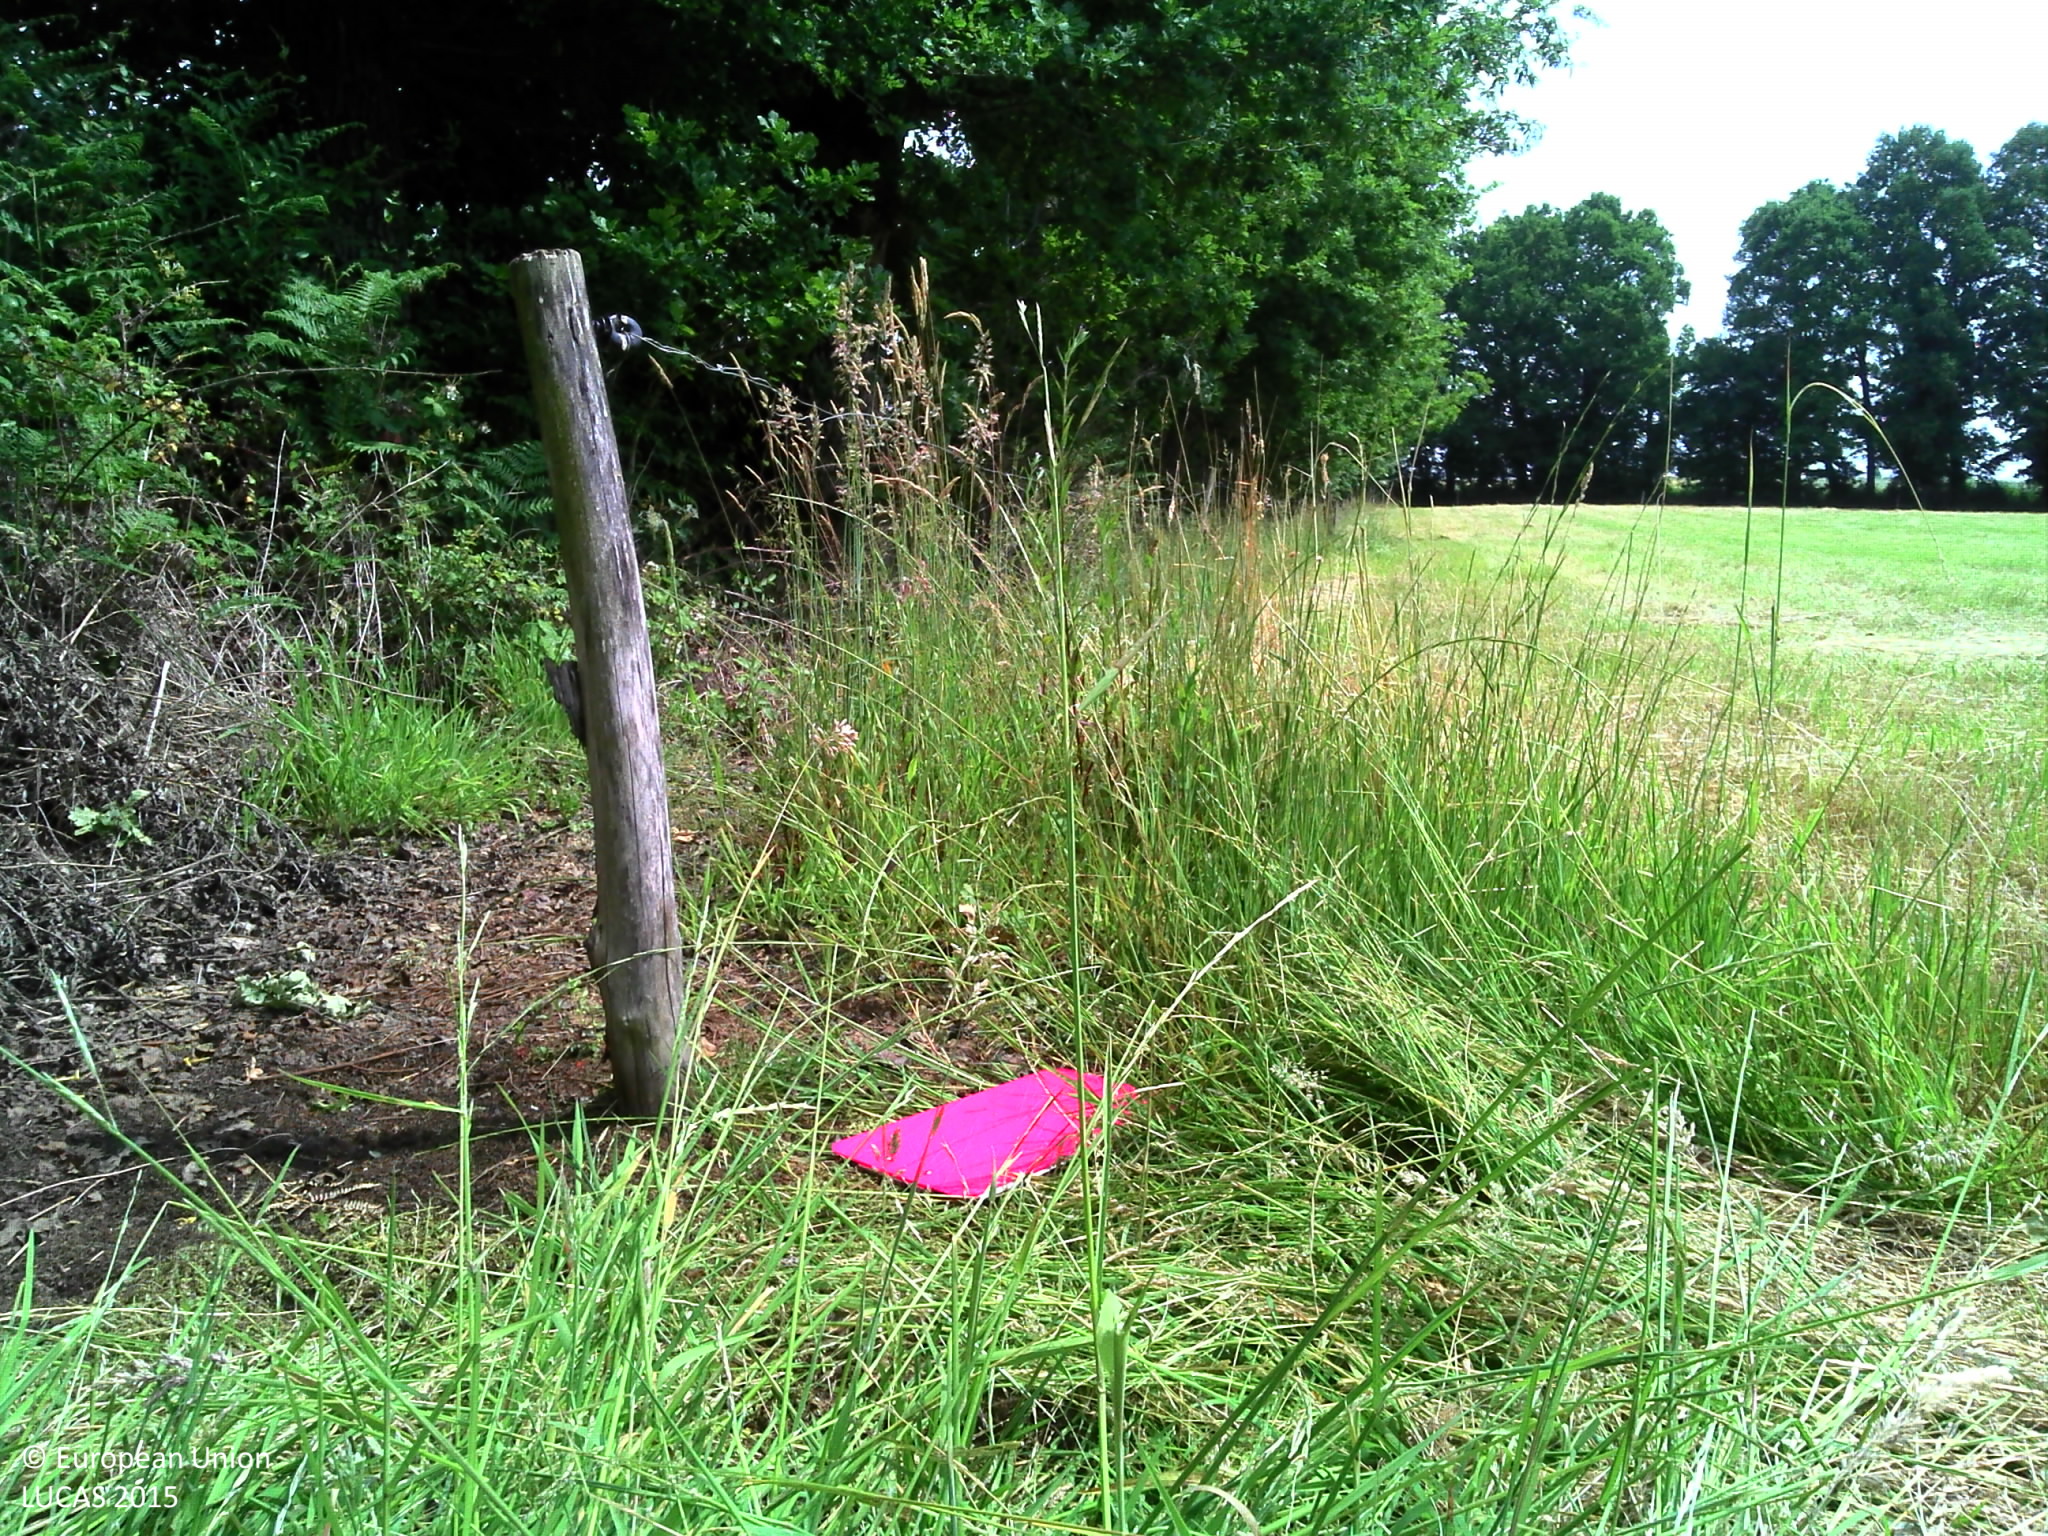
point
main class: Grassland
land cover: Grassland without tree/shrub cover
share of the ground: > 75 %
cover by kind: herbaceous plants 100 %
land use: Agriculture (excluding fallow land and kitchen gardens)
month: June
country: FR
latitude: 48.1355
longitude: -2.1079
